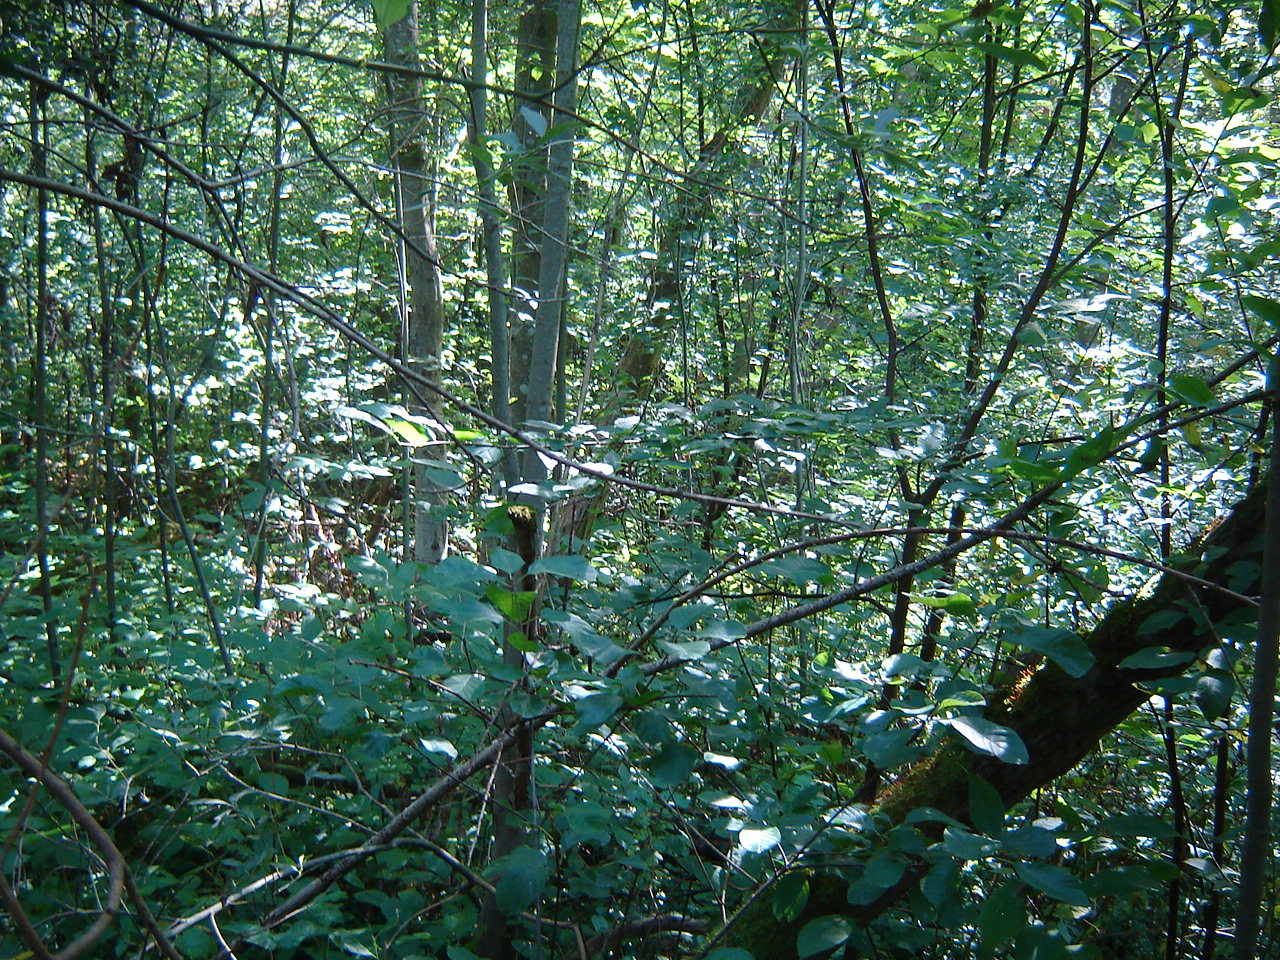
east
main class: Woodland
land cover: Broadleaved woodland
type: non-riverine alder, birch or aspen forest
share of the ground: > 75 %
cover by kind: broadleaved forest trees 85 %, herbaceous plants 15 %
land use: Forestry
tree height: > 5 m
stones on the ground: < 10 %
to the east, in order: Broadleaved woodland; Other mixed woodland; Pine dominated mixed woodland; Paved roads, cycling and walking lanes; Grass margins; Electric lines; Grass margins; Durum wheat
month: August
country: LT
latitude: 54.8400
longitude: 25.3032
